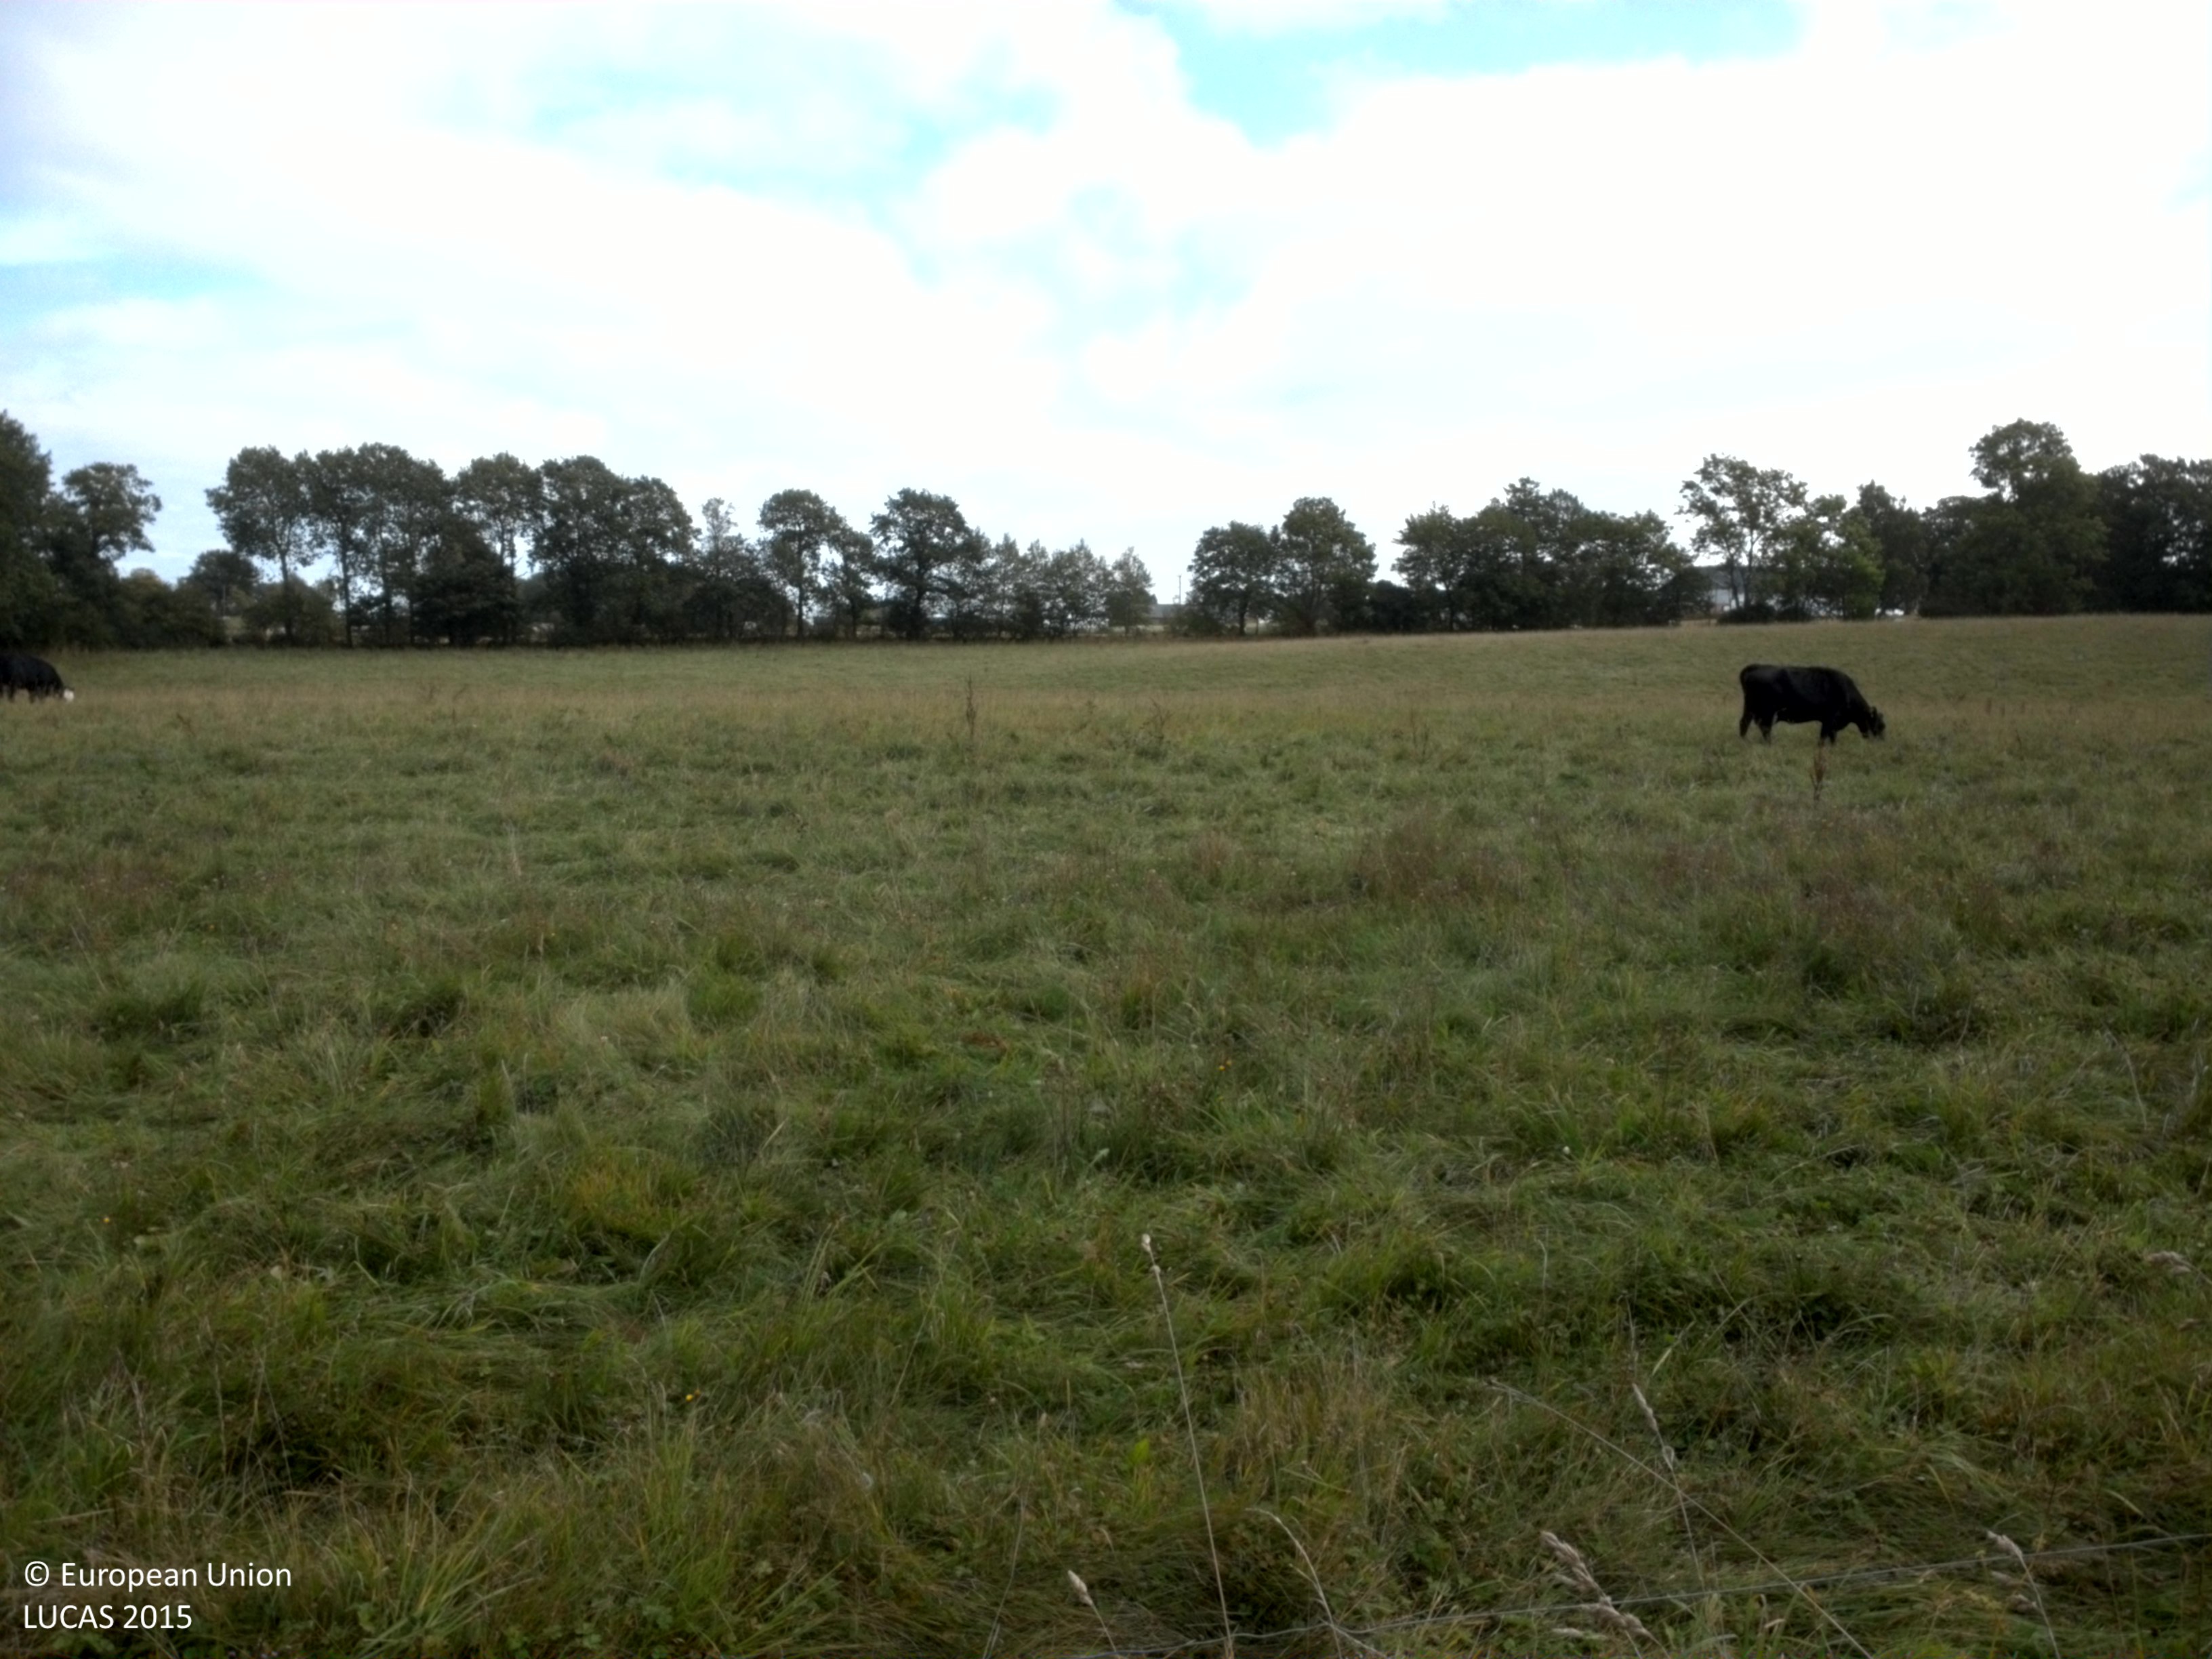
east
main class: Grassland
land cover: Grassland without tree/shrub cover
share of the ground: > 75 %
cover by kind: herbaceous plants 100 %
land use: Agriculture (excluding fallow land and kitchen gardens)
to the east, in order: Tracks; Grass margins; Fences; Grassland without tree/shrub cover; Managed hedges; Dry stone walls; Barley
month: October
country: SE
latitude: 55.7383
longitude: 13.7091
